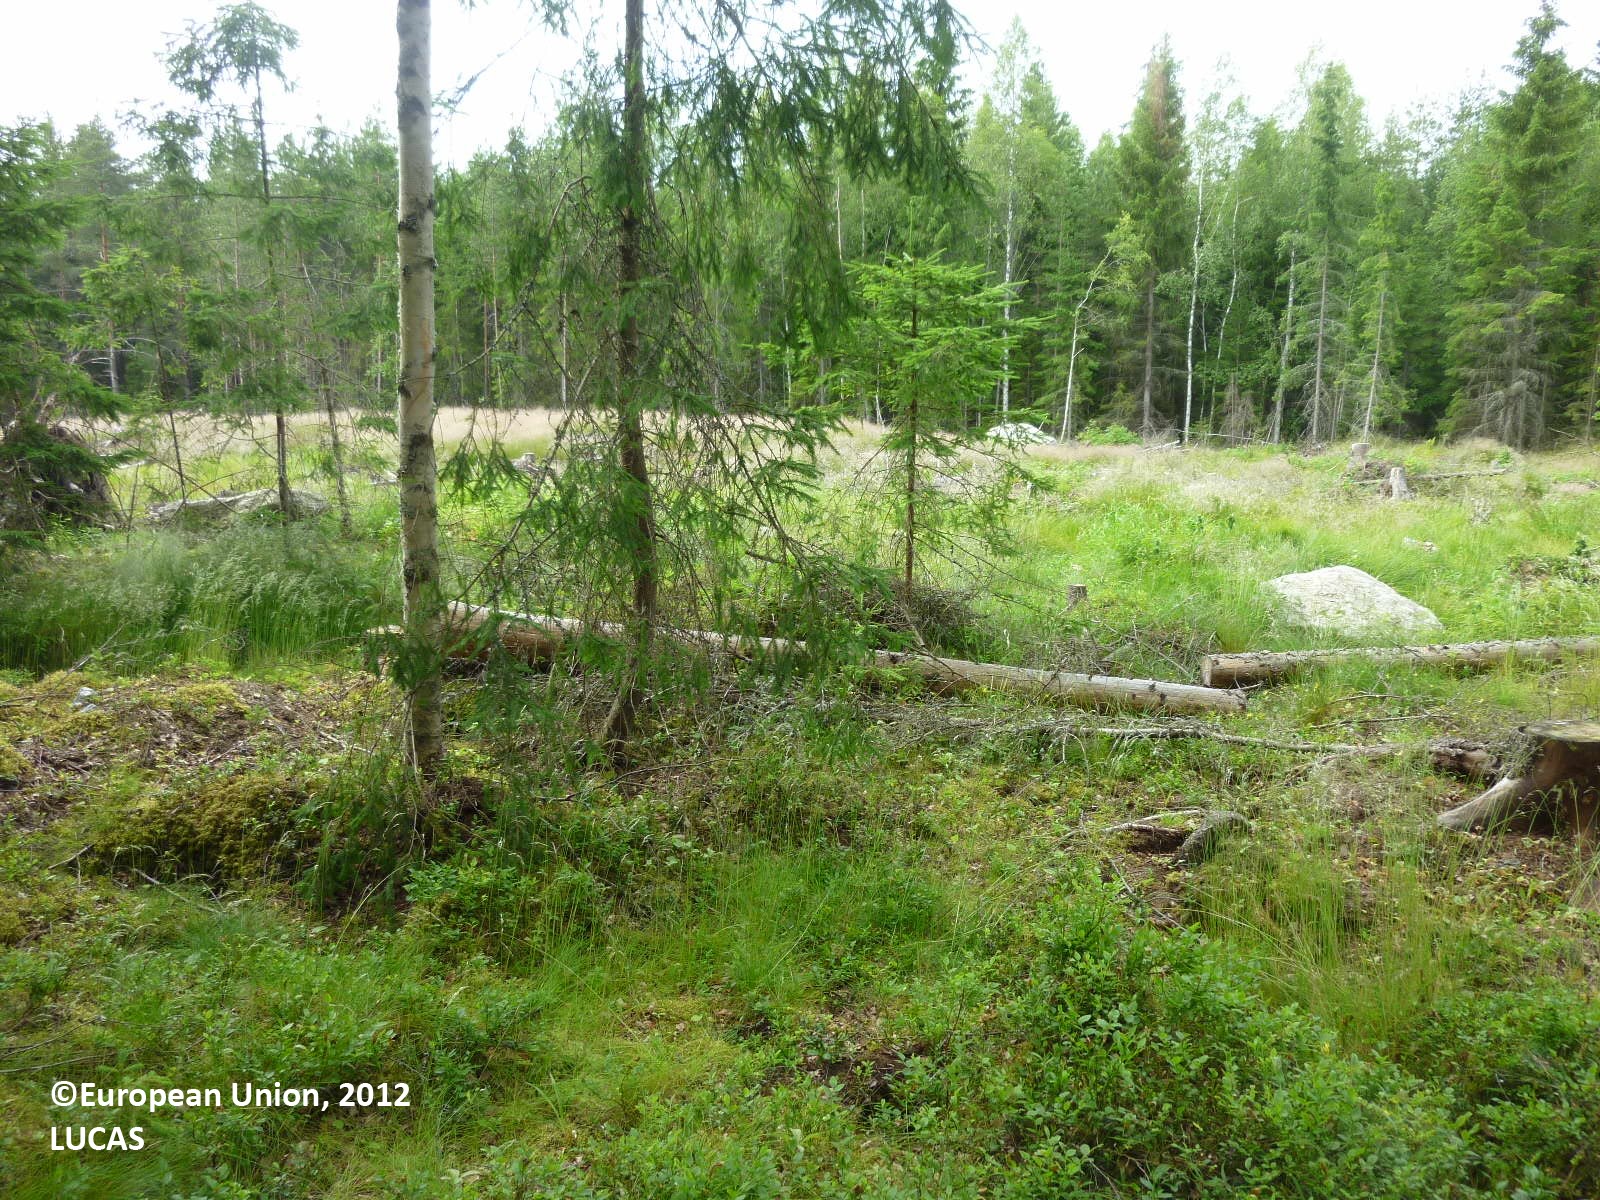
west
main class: Woodland
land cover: Spruce dominated mixed woodland
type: boreal forest
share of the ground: > 75 %
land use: Forestry
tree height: > 5 m
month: July
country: FI
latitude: 61.1375
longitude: 22.7161
